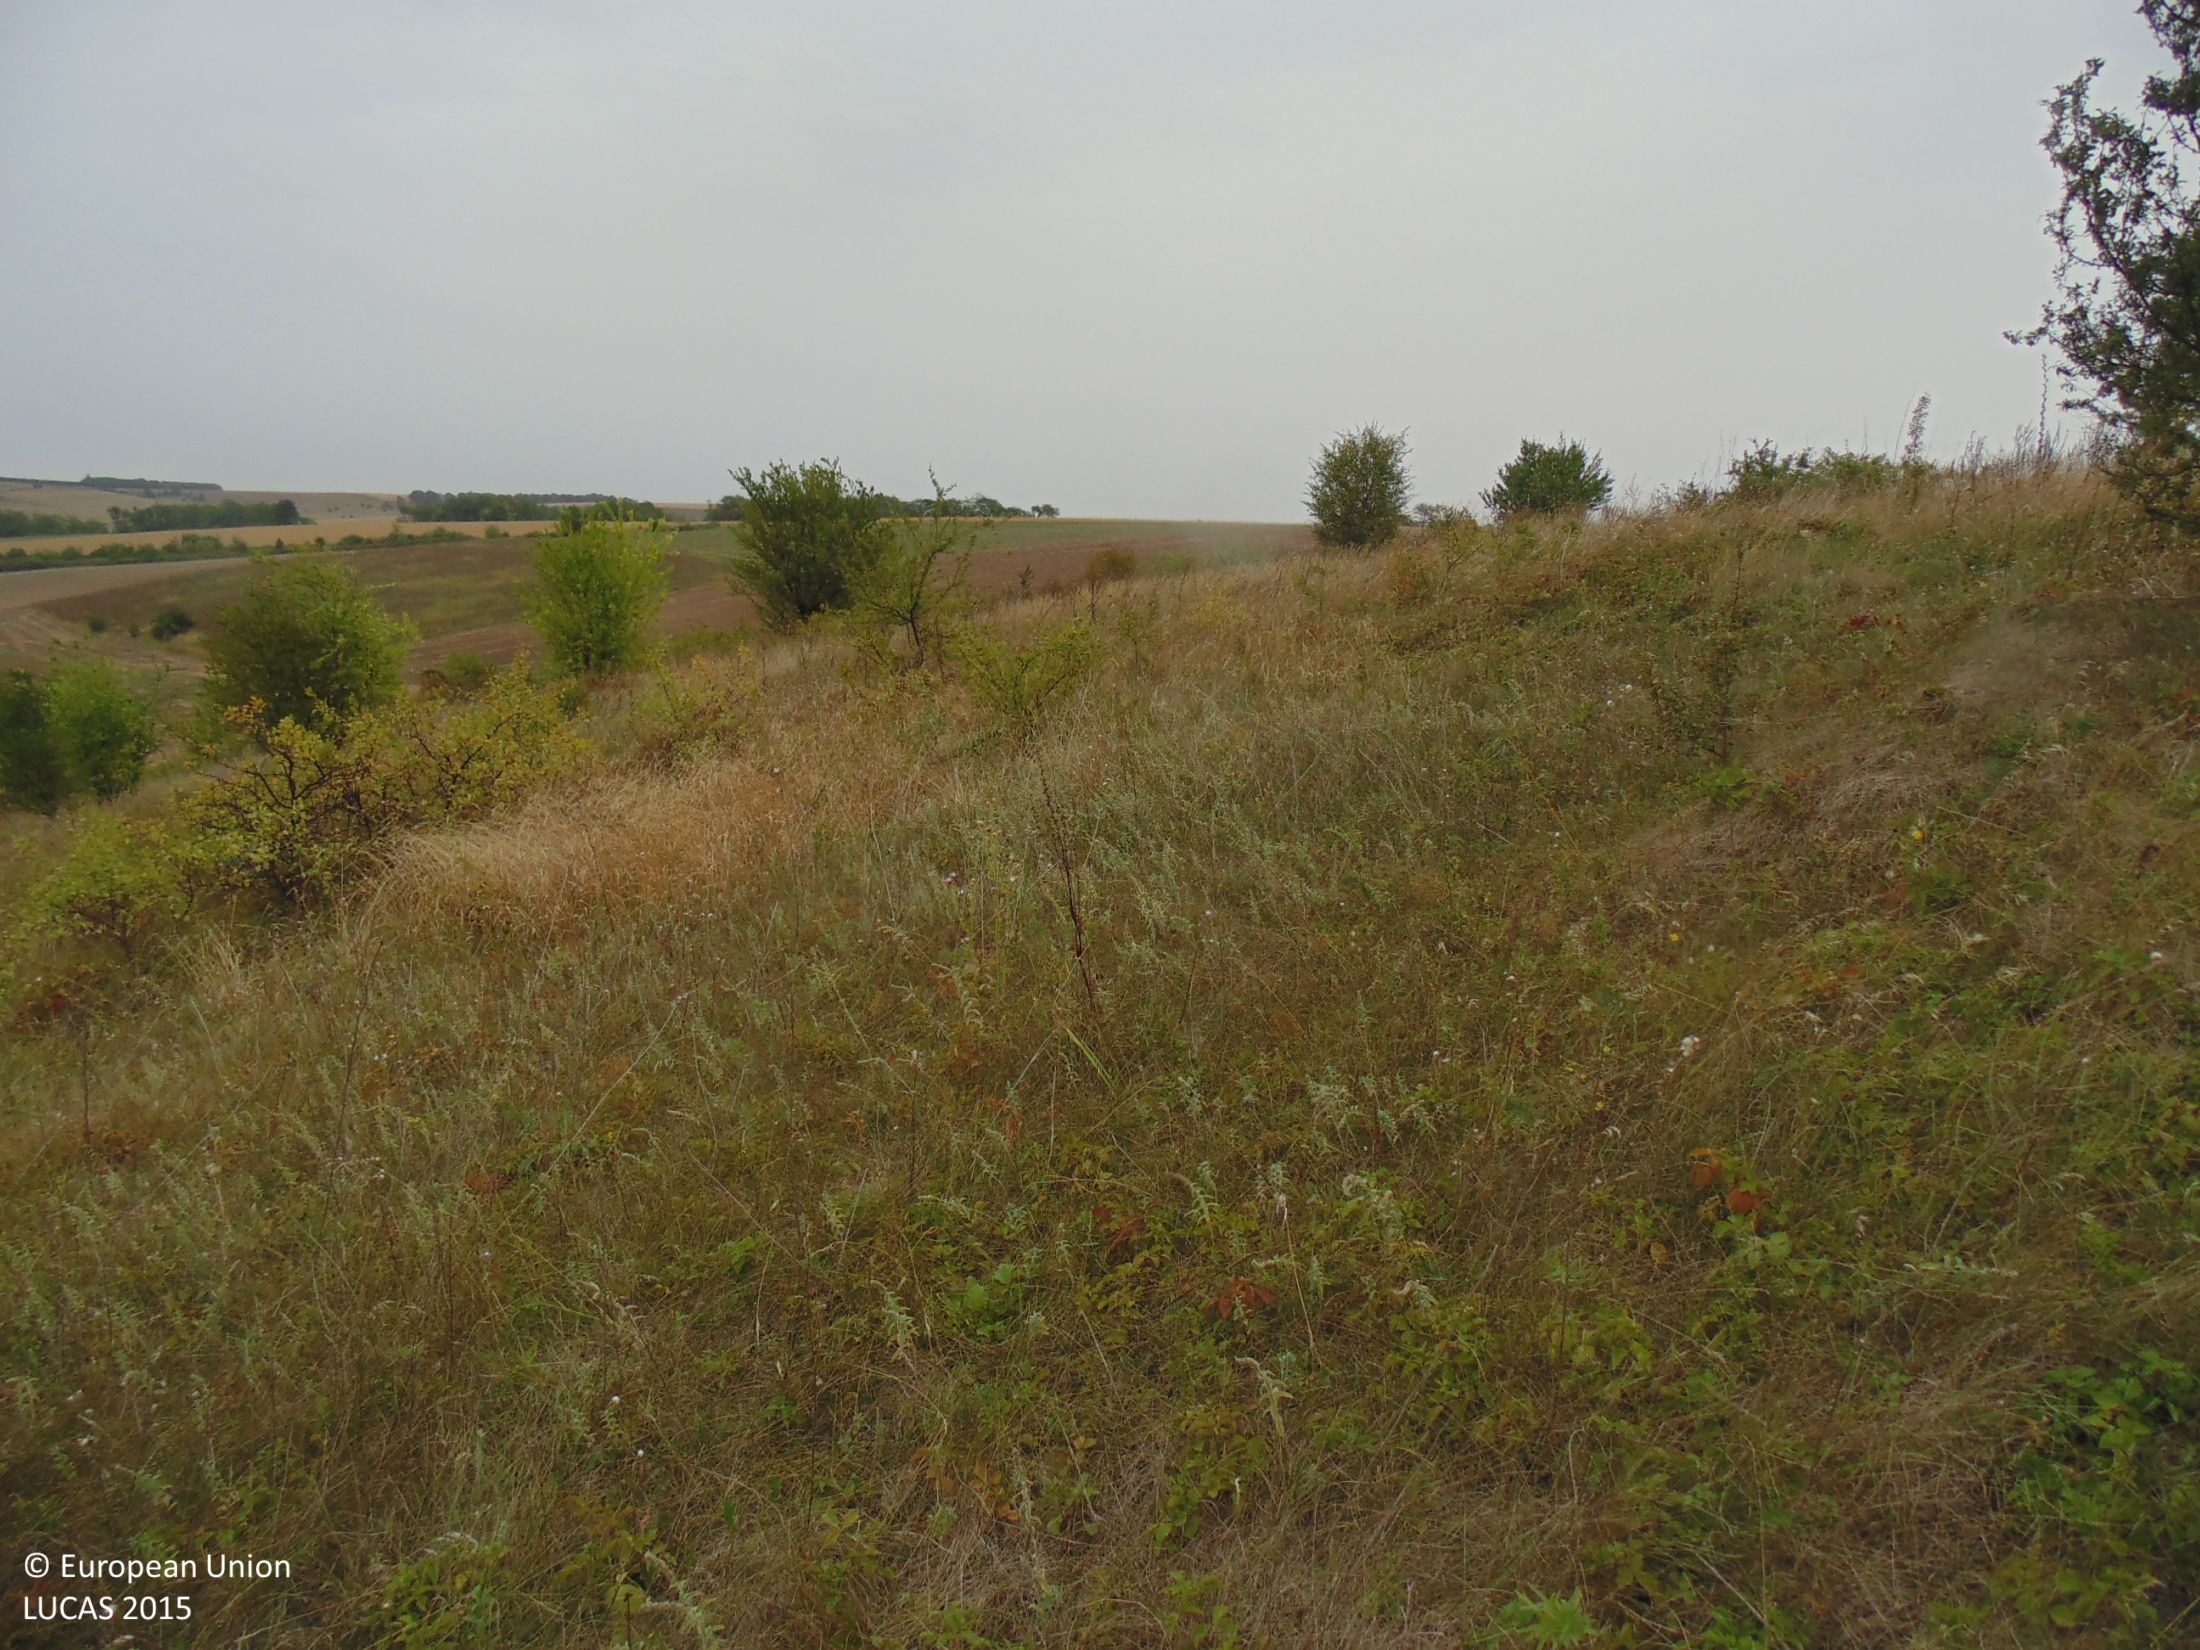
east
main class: Grassland
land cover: Grassland with sparse tree/shrub cover
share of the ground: > 75 %
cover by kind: herbaceous plants 85 %, shrubs 10 %, broadleaved forest trees 5 %
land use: Semi-natural and natural areas not in use
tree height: < 5 m
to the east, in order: Grassland with sparse tree/shrub cover; Sunflower
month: September
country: BG
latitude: 43.9976
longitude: 26.9187
